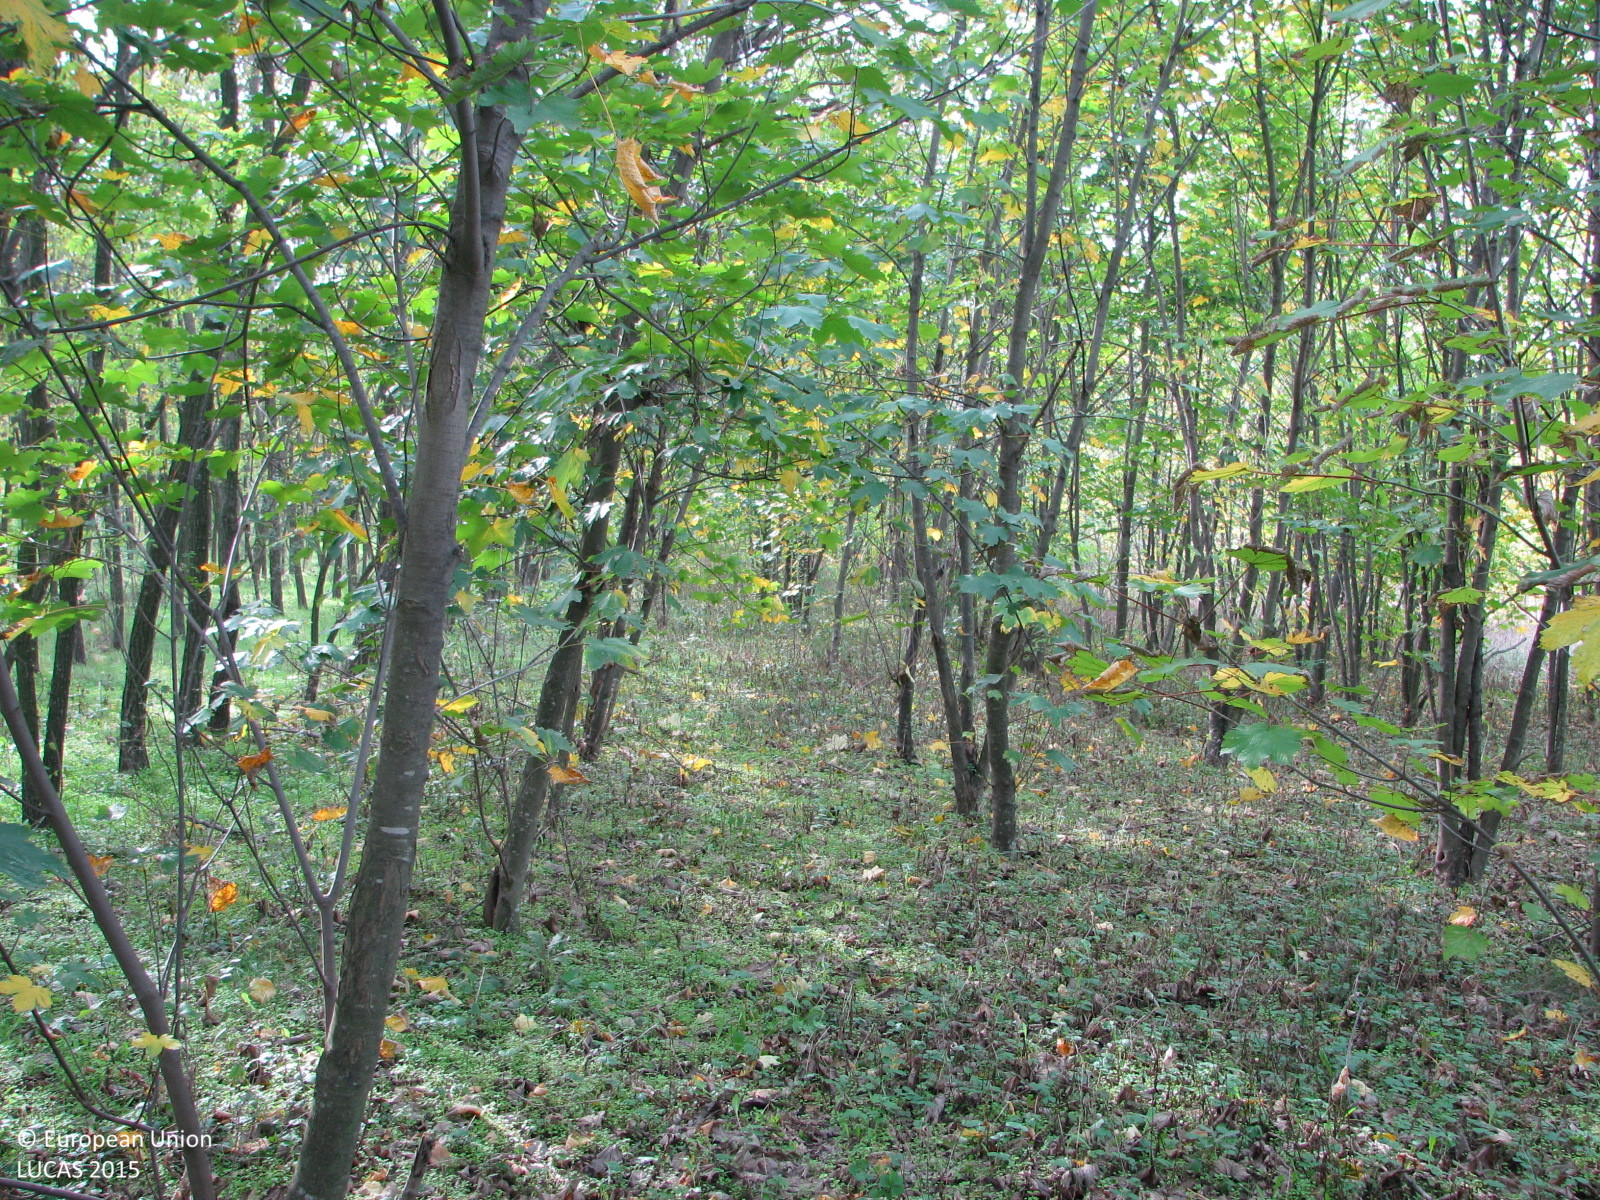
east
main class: Woodland
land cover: Broadleaved woodland
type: mesophytic deciduous forest
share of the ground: 50 - 75 %
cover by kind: broadleaved forest trees 70 %, herbaceous plants 30 %
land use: Forestry
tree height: > 5 m
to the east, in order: Broadleaved woodland; Grass margins; Tracks; Grassland without tree/shrub cover
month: October
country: BG
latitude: 42.4707
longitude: 26.6990
